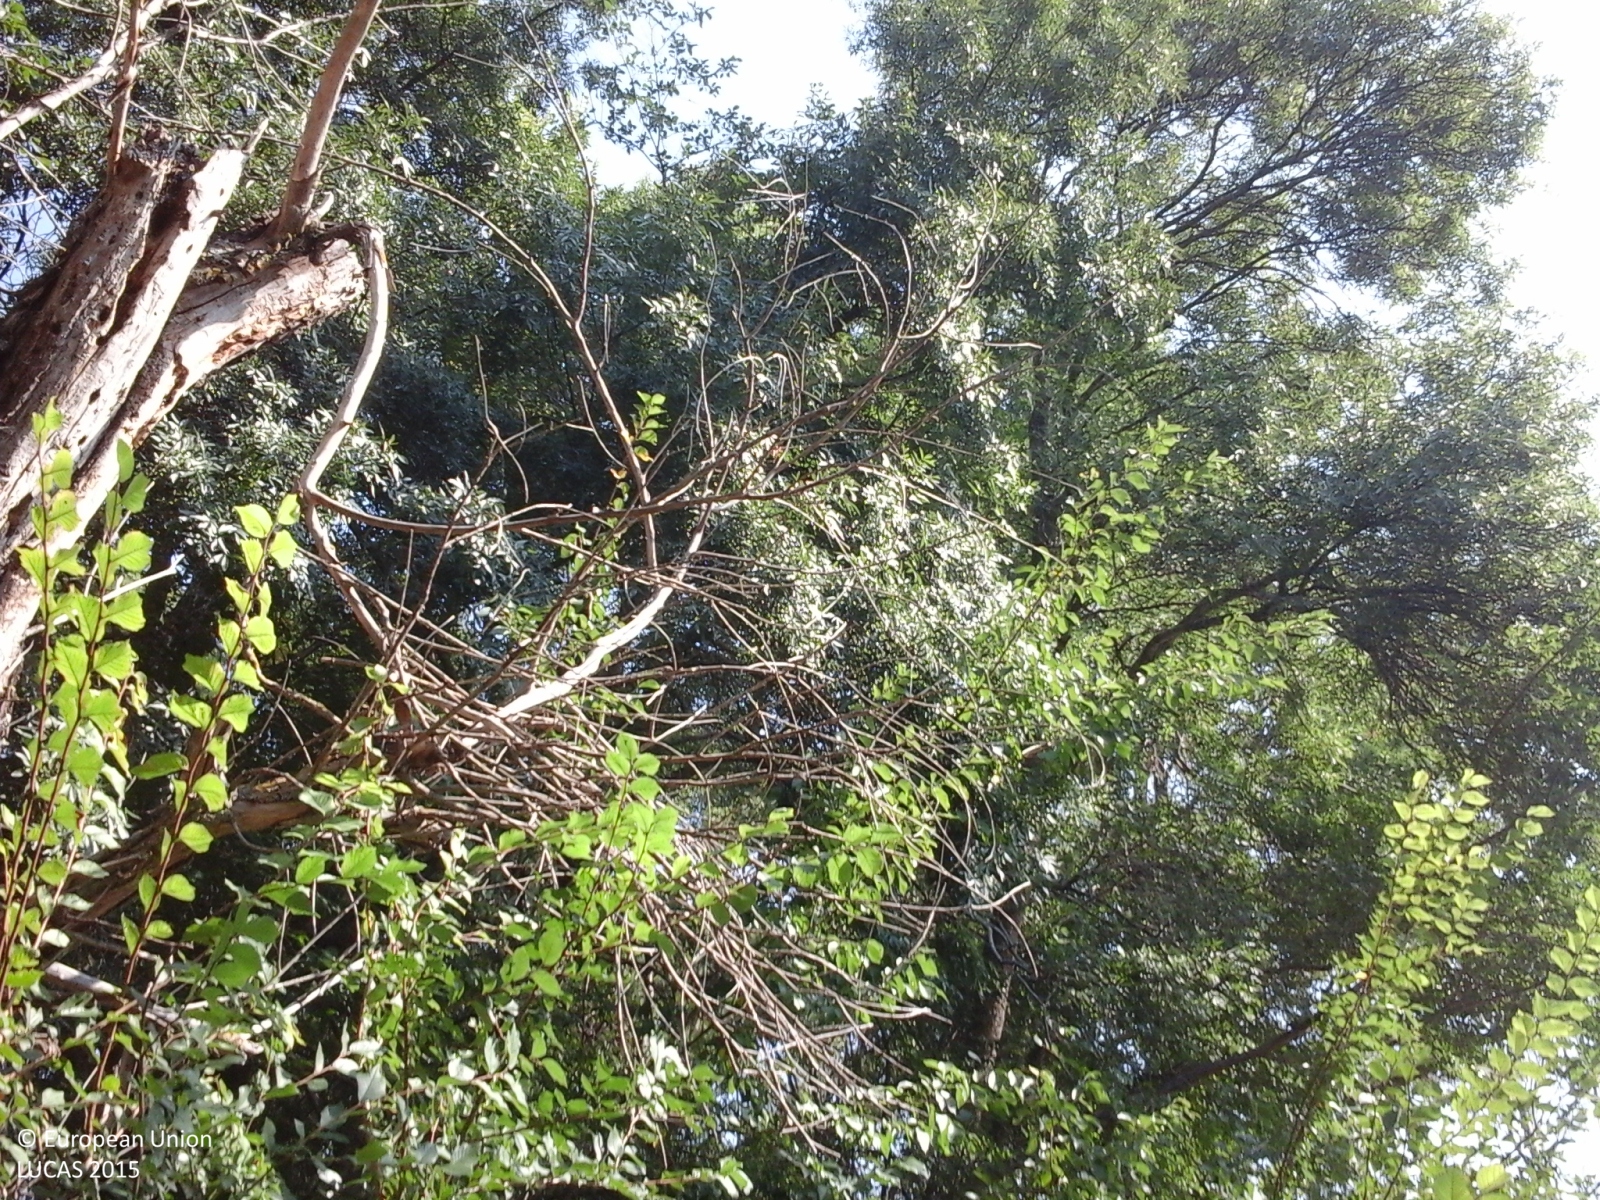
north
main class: Woodland
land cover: Broadleaved woodland
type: thermophilous deciduous forest
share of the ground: > 75 %
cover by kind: broadleaved forest trees 90 %, shrubs 5 %, herbaceous plants 5 %
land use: Forestry
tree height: > 5 m
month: August
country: IT
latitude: 41.4386
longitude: 15.1168
